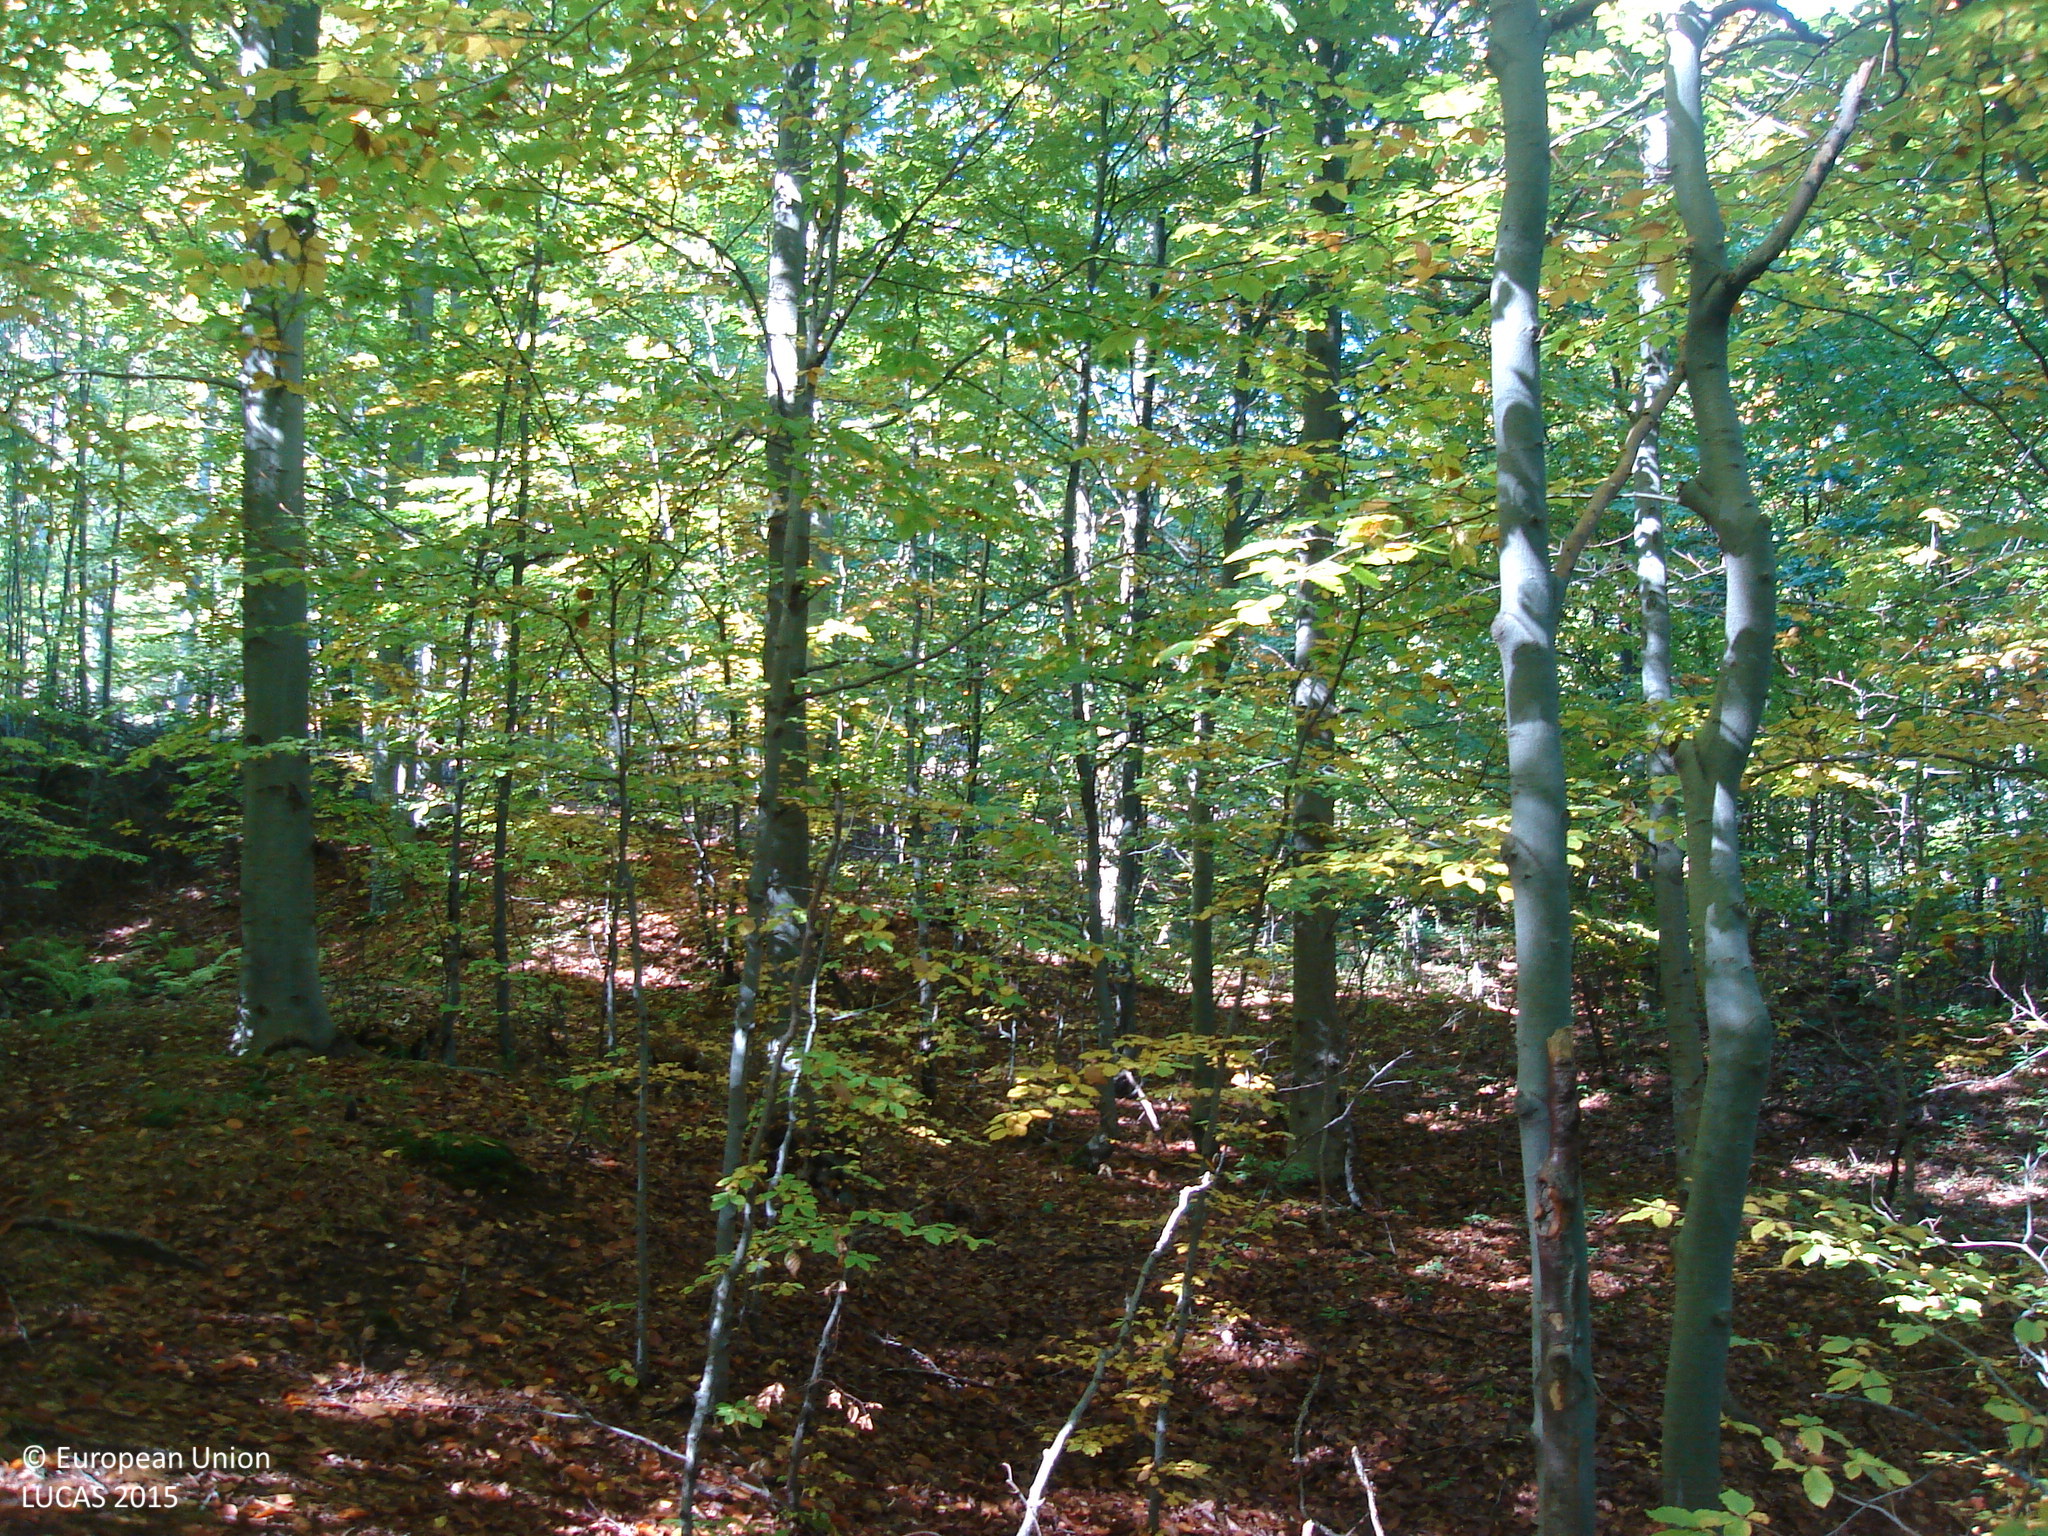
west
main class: Woodland
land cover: Broadleaved woodland
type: mountainous beech forest
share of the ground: > 75 %
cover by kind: broadleaved forest trees 80 %, unconsolidated bare surface 20 %
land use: Forestry
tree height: > 5 m
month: October
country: BG
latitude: 42.6144
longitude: 24.2254
